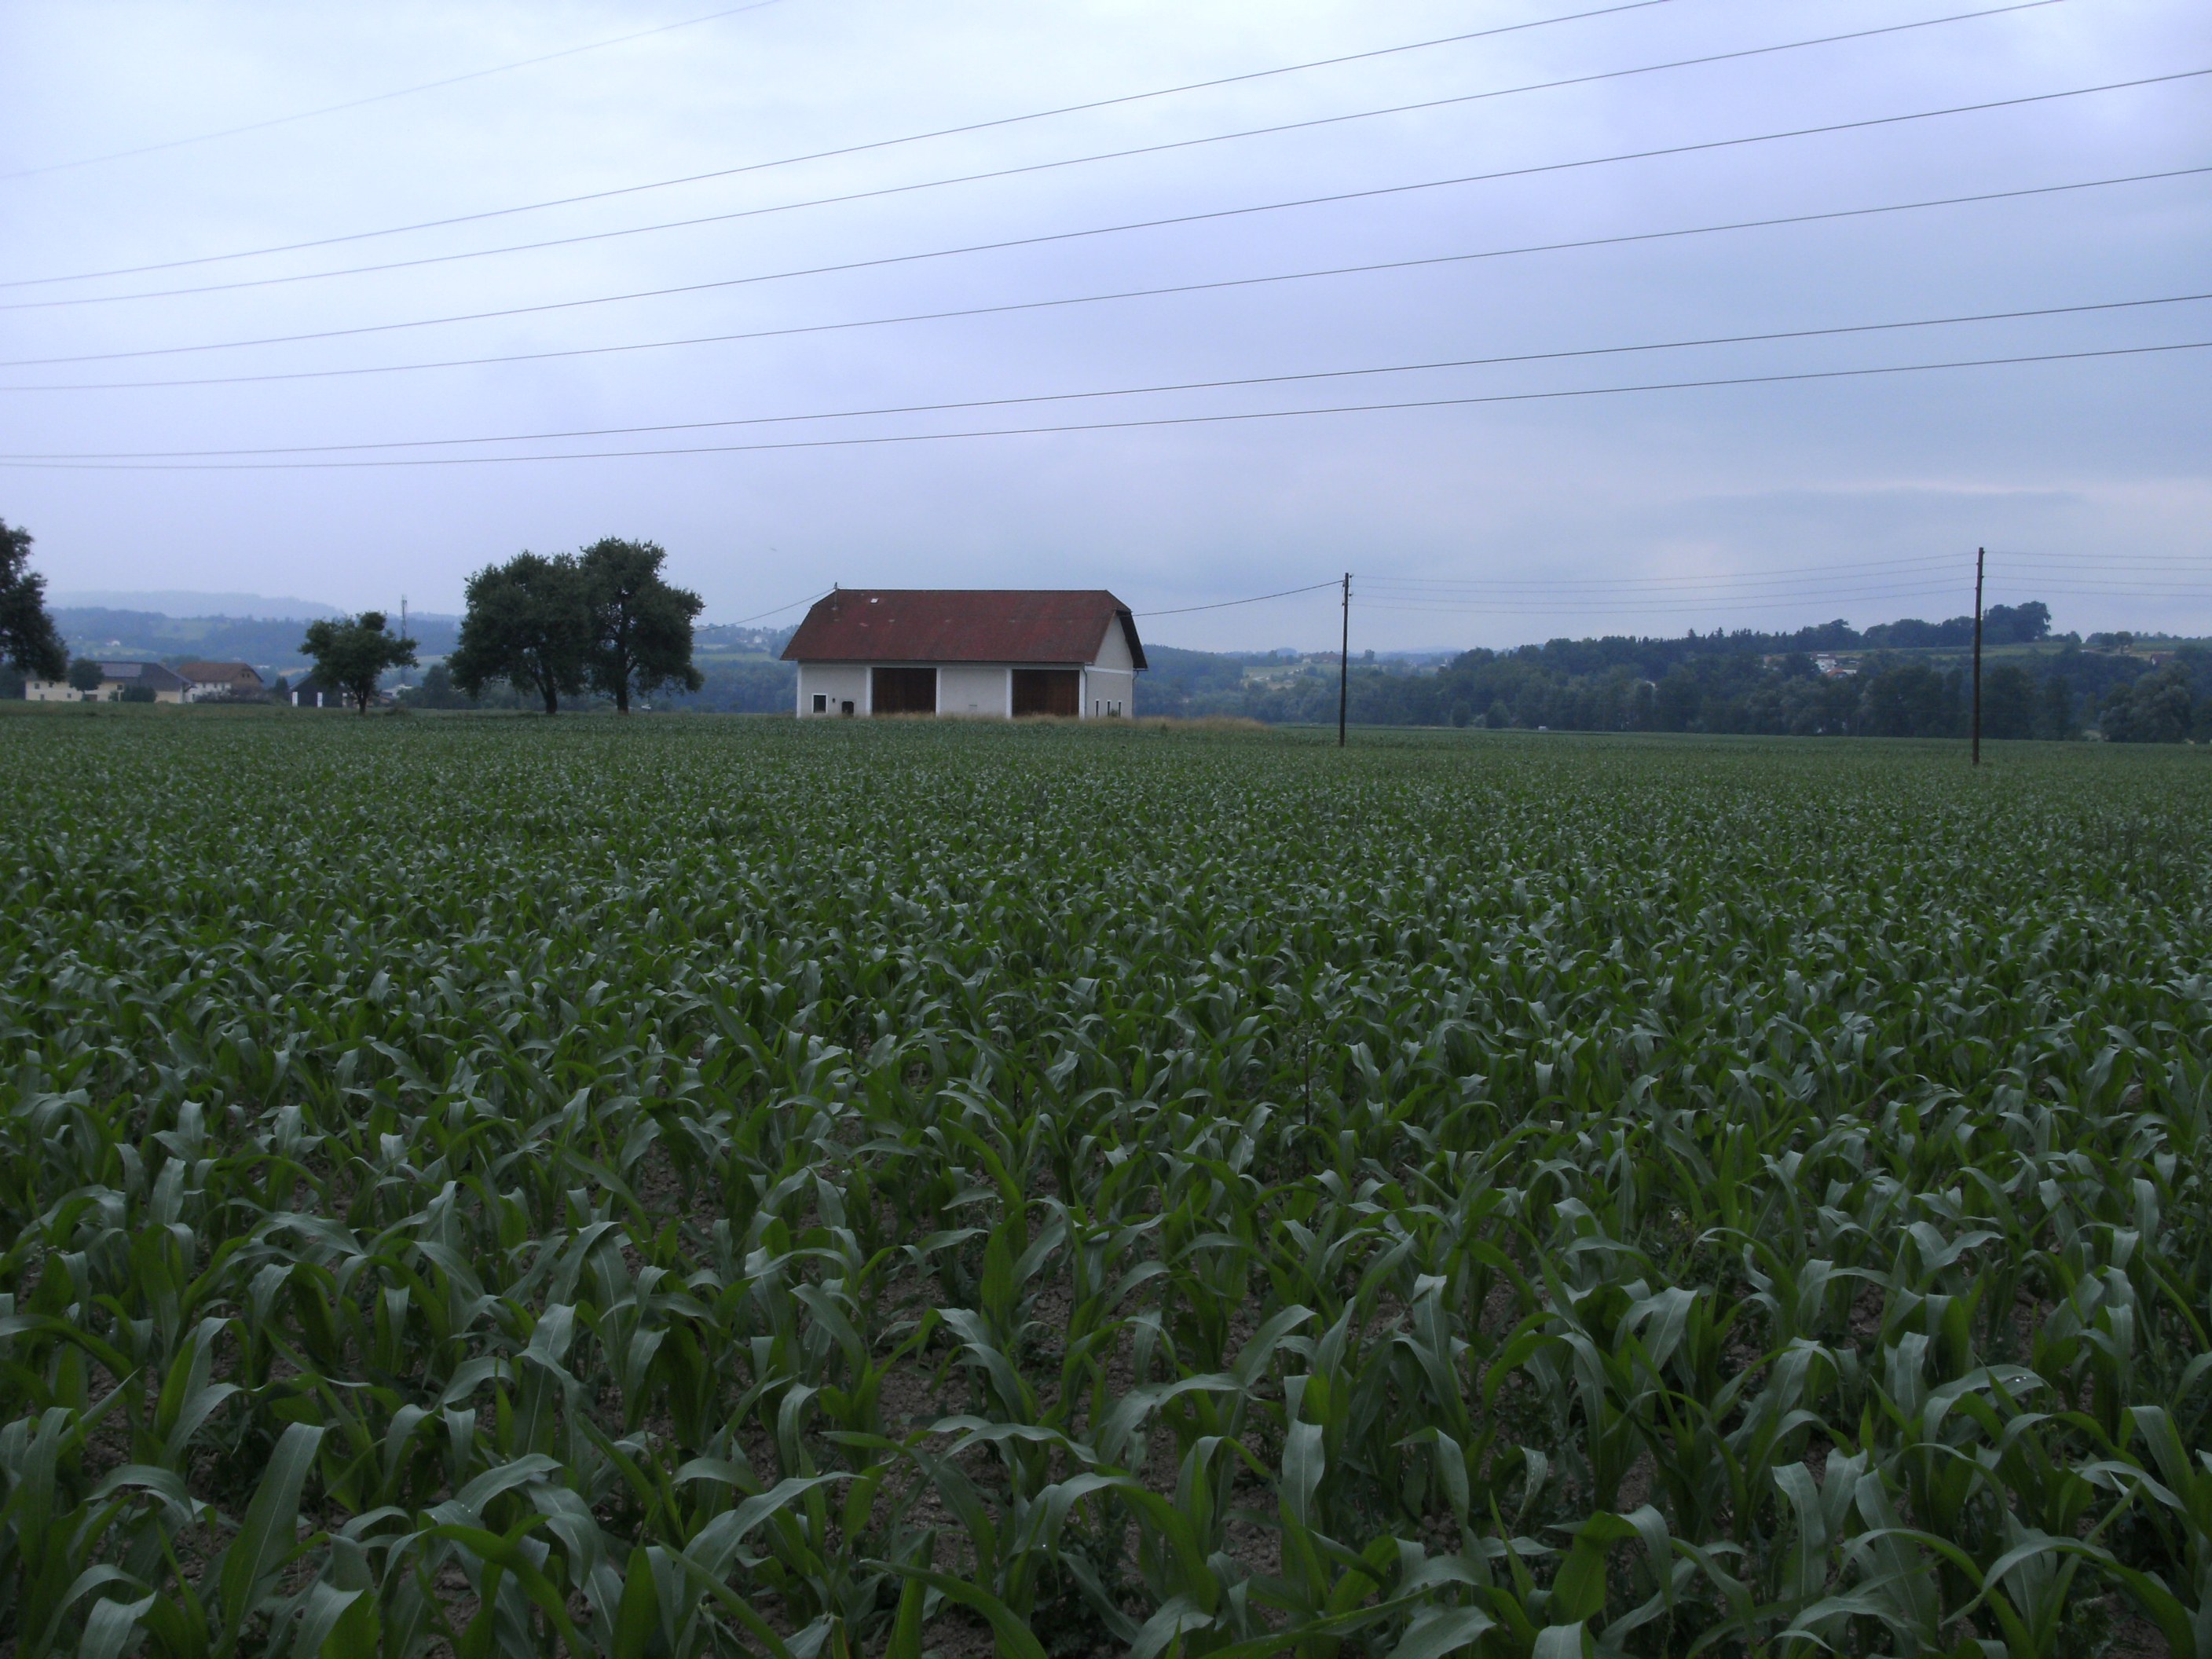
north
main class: Cropland
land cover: Maize
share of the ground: 50 - 75 %
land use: Agriculture (excluding fallow land and kitchen gardens)
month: June
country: AT
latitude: 48.3270
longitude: 14.1138
